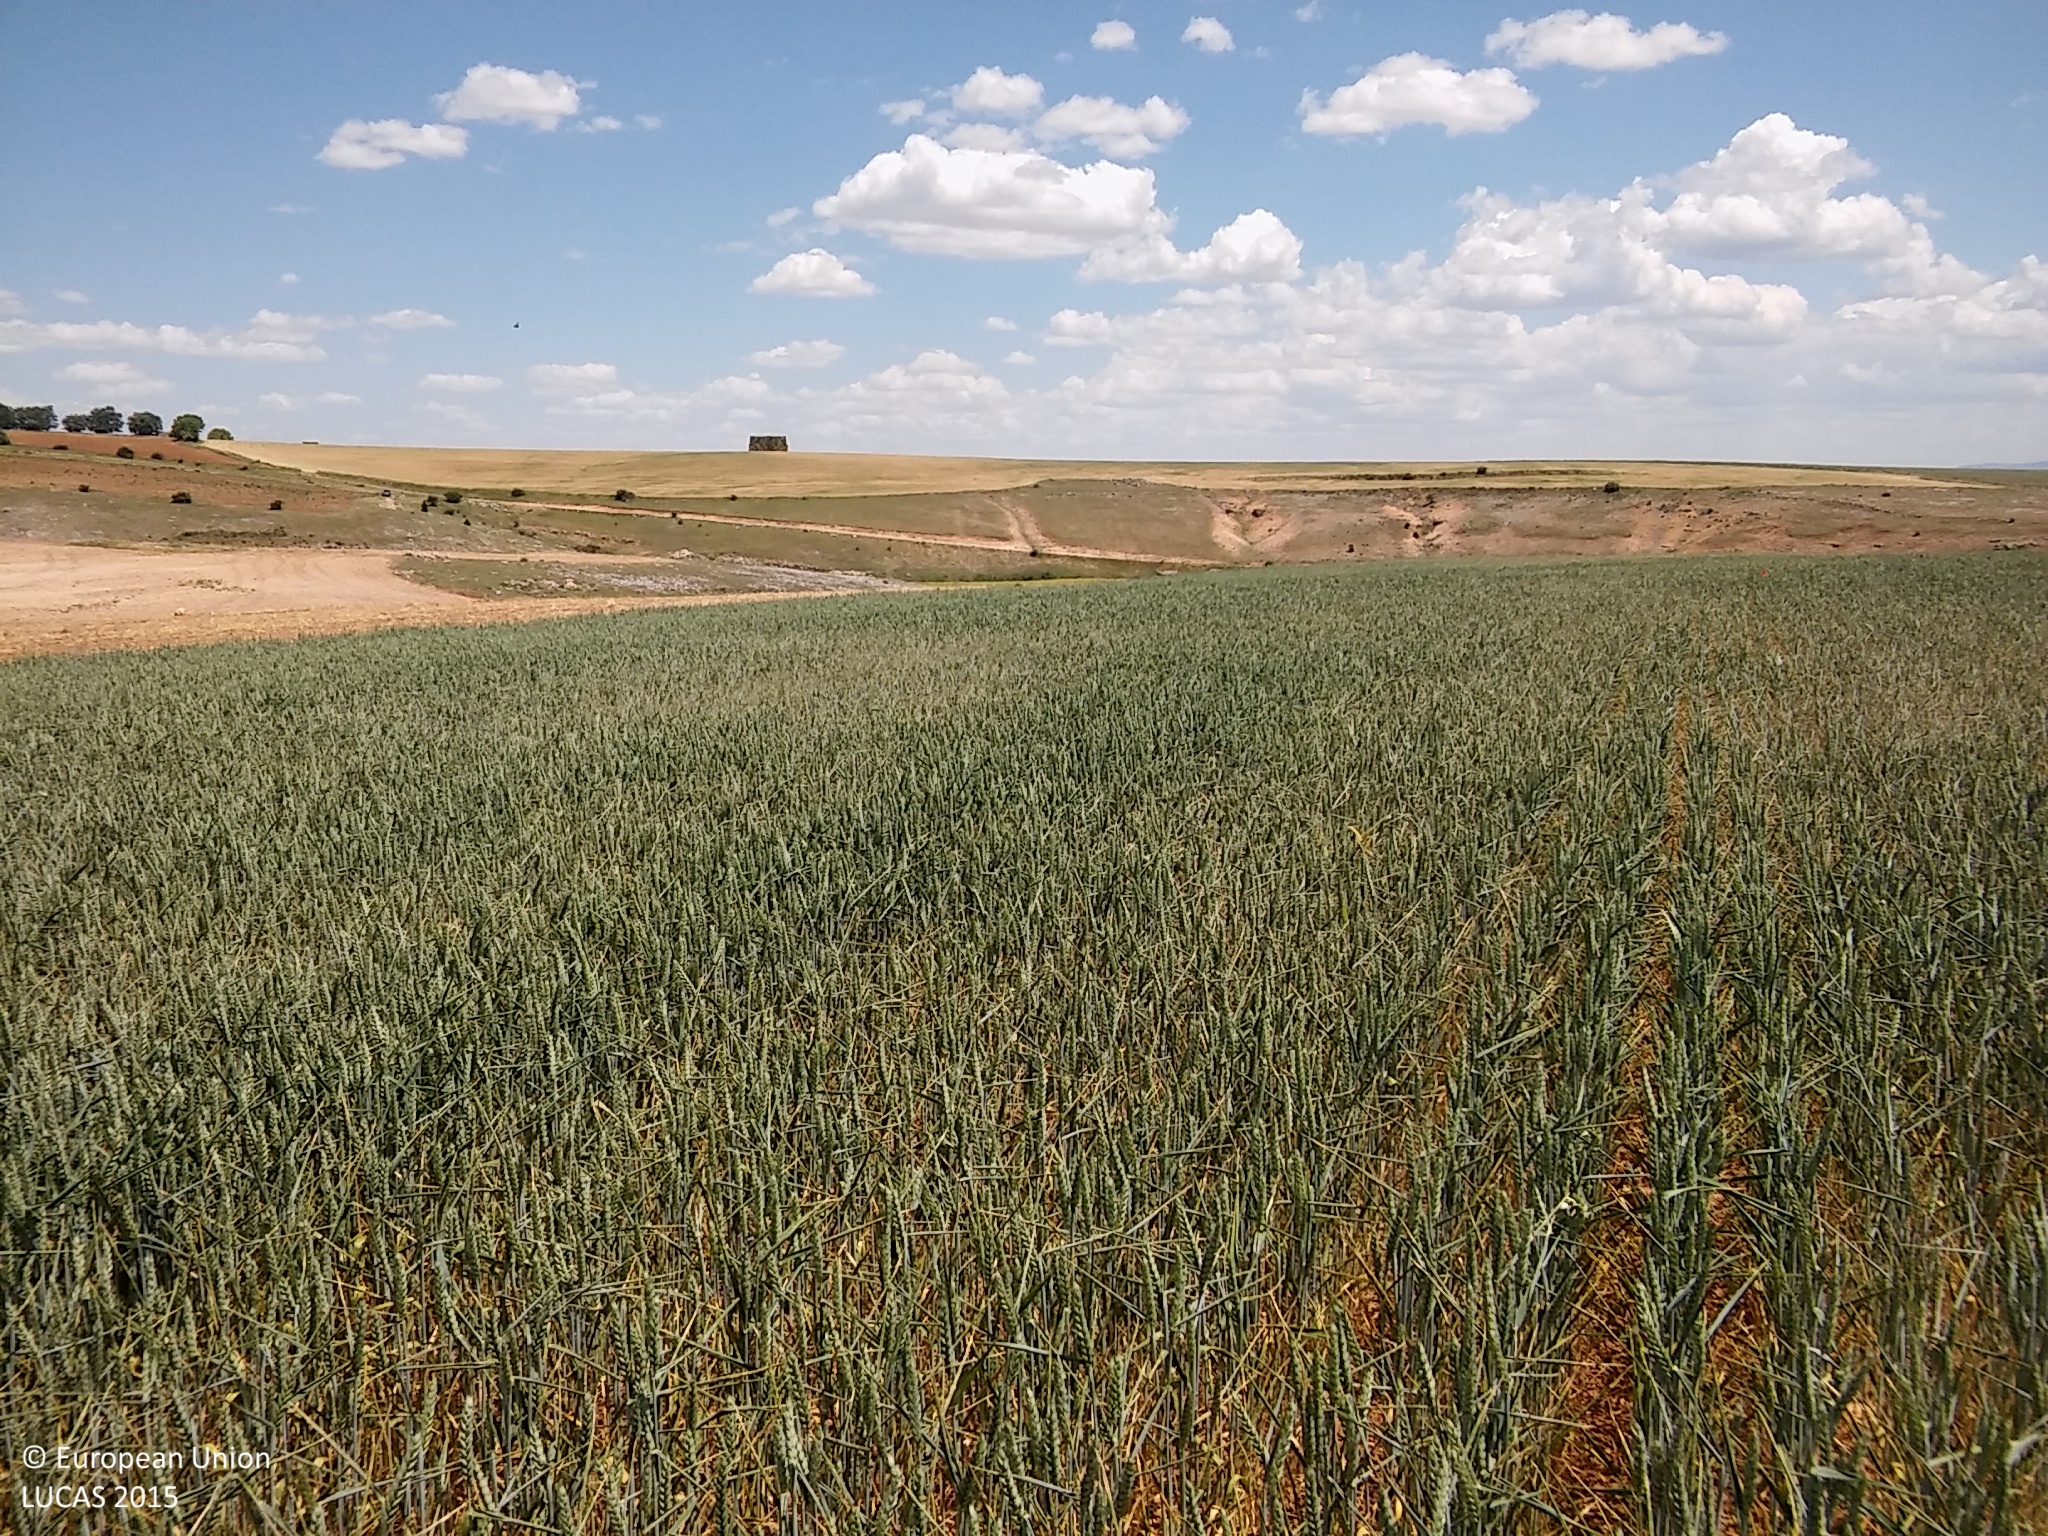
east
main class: Cropland
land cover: Common wheat
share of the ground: > 75 %
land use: Agriculture (excluding fallow land and kitchen gardens)
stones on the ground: 10 - 25 %
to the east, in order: Common wheat; Barley; Common wheat
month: June
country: ES
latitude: 41.3620
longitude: -3.7615
